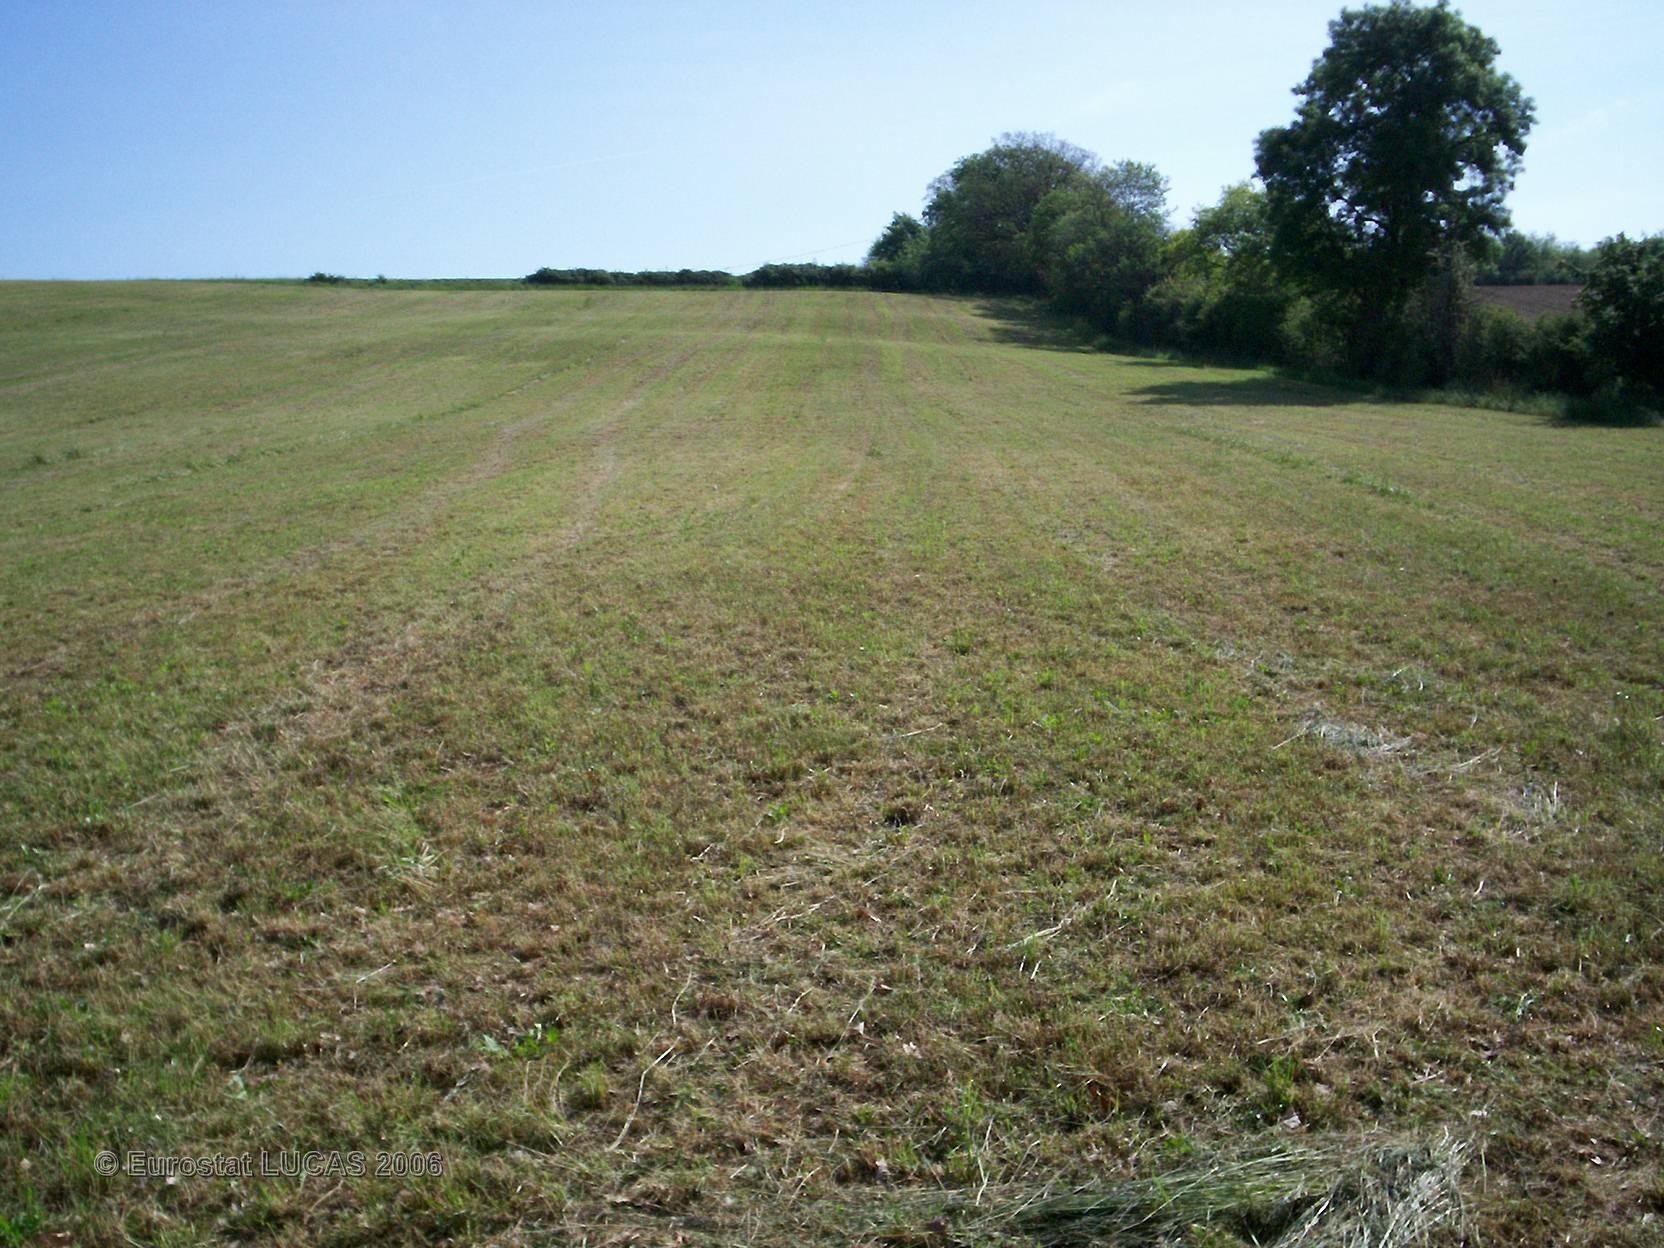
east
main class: Grassland
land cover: Grassland without tree/shrub cover
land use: Agriculture (excluding fallow land and kitchen gardens)
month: May
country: FR
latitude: 43.8187
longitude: 0.2594
